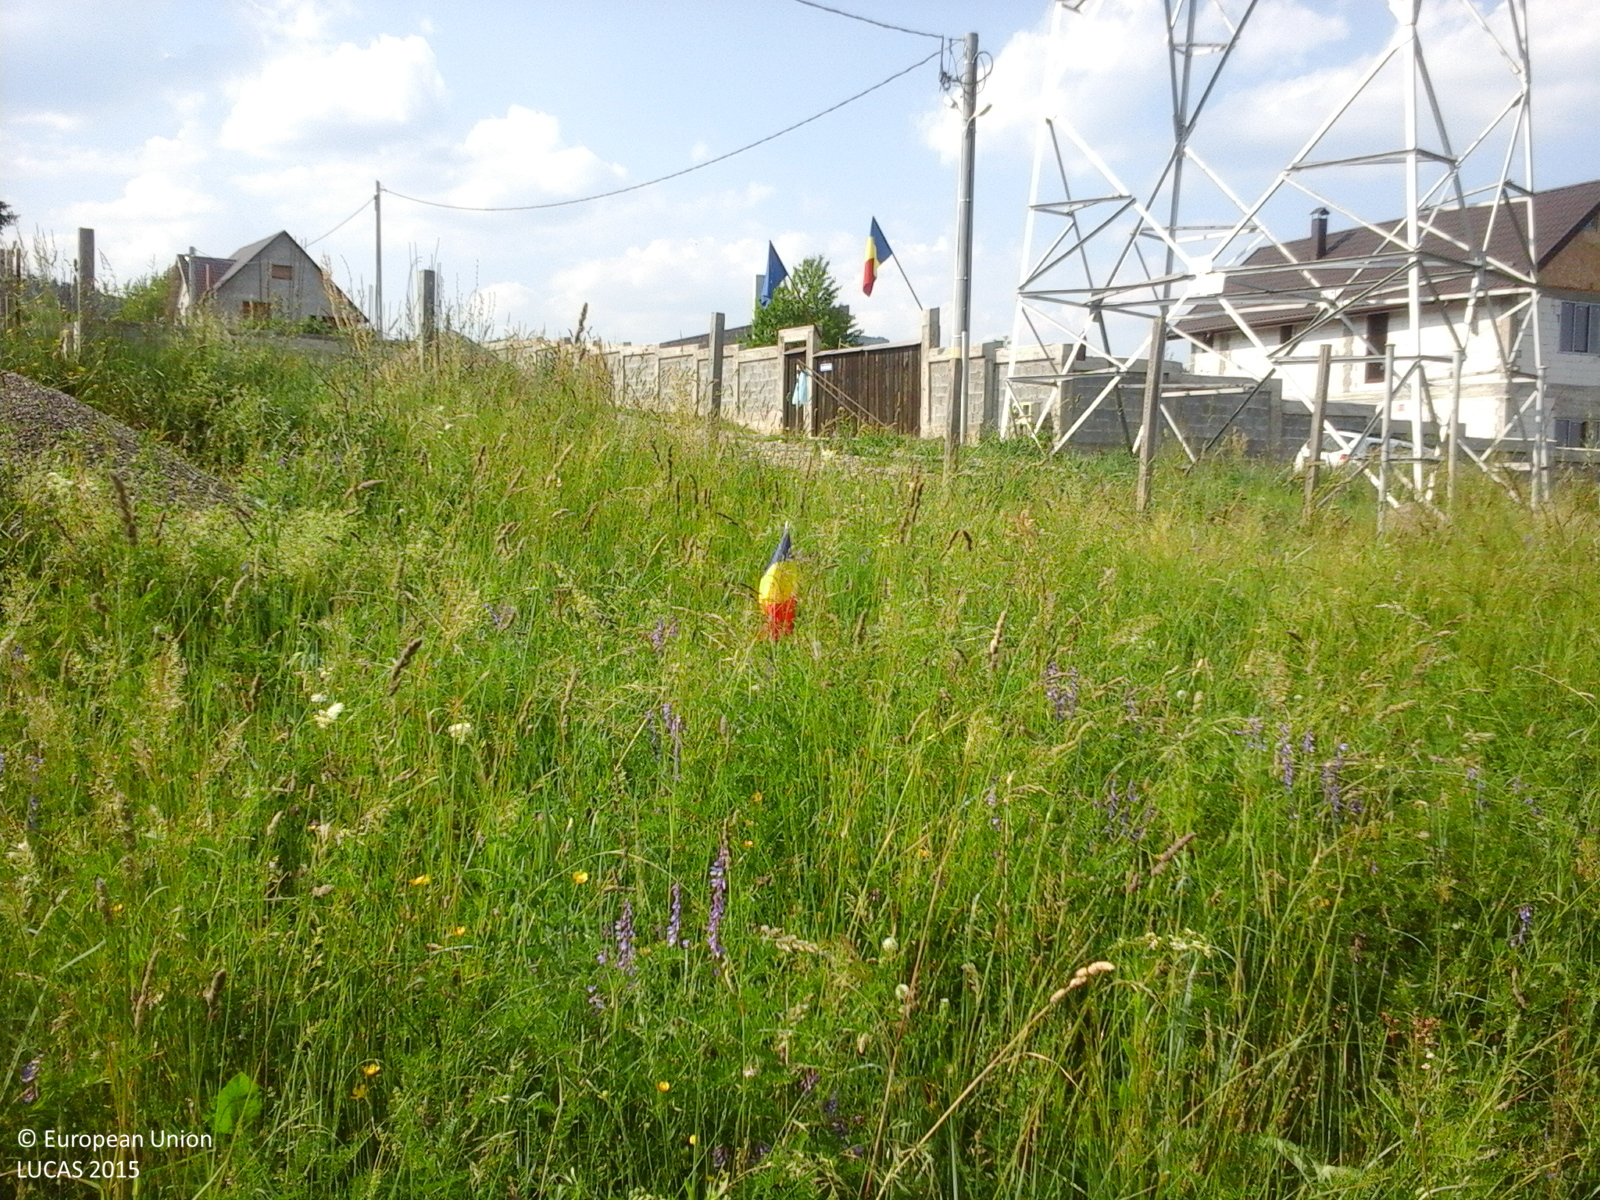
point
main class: Cropland
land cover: Other leguminous and mixtures for fodder
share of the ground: > 75 %
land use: Agriculture (excluding fallow land and kitchen gardens)
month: June
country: RO
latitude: 46.9477
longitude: 26.2788
